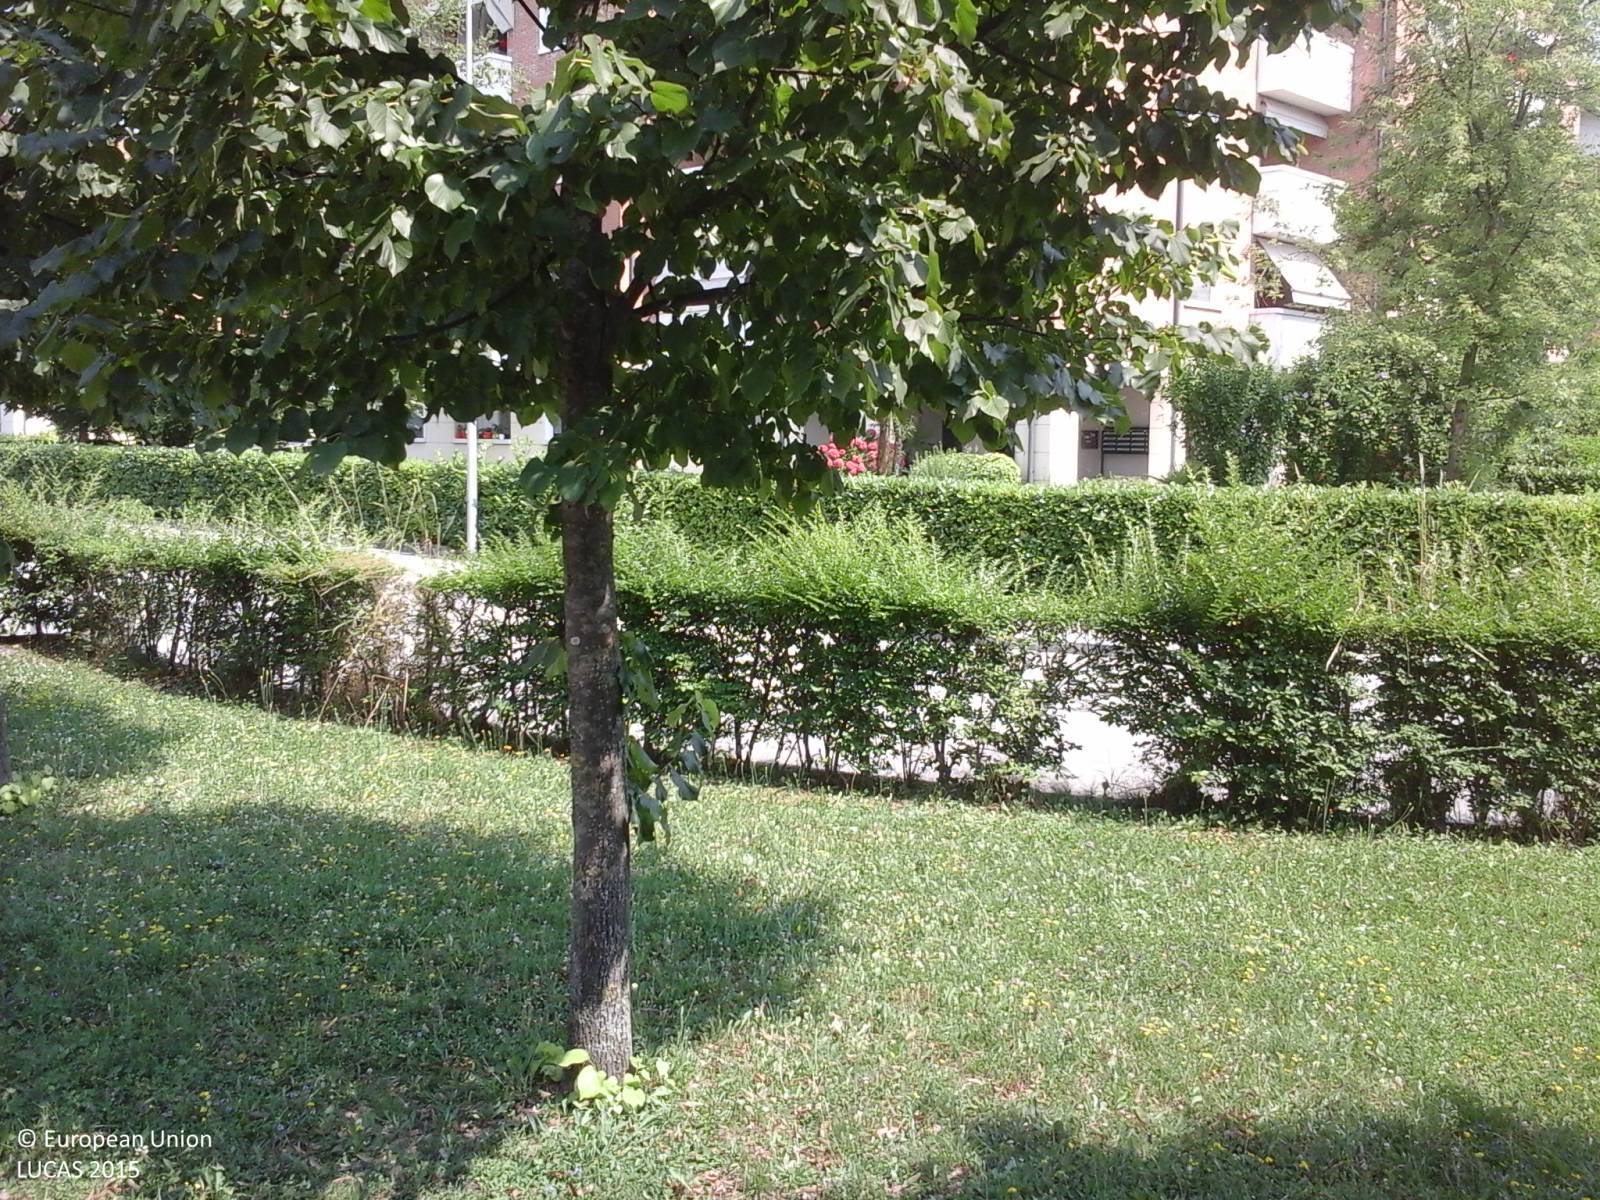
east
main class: Grassland
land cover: Grassland with sparse tree/shrub cover
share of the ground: > 75 %
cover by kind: herbaceous plants 95 %, broadleaved forest trees 5 %
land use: Community services
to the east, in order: Grassland with sparse tree/shrub cover; Artificial constructions in urban areas; Grassland with sparse tree/shrub cover
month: July
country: IT
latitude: 45.9395
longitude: 12.6666
